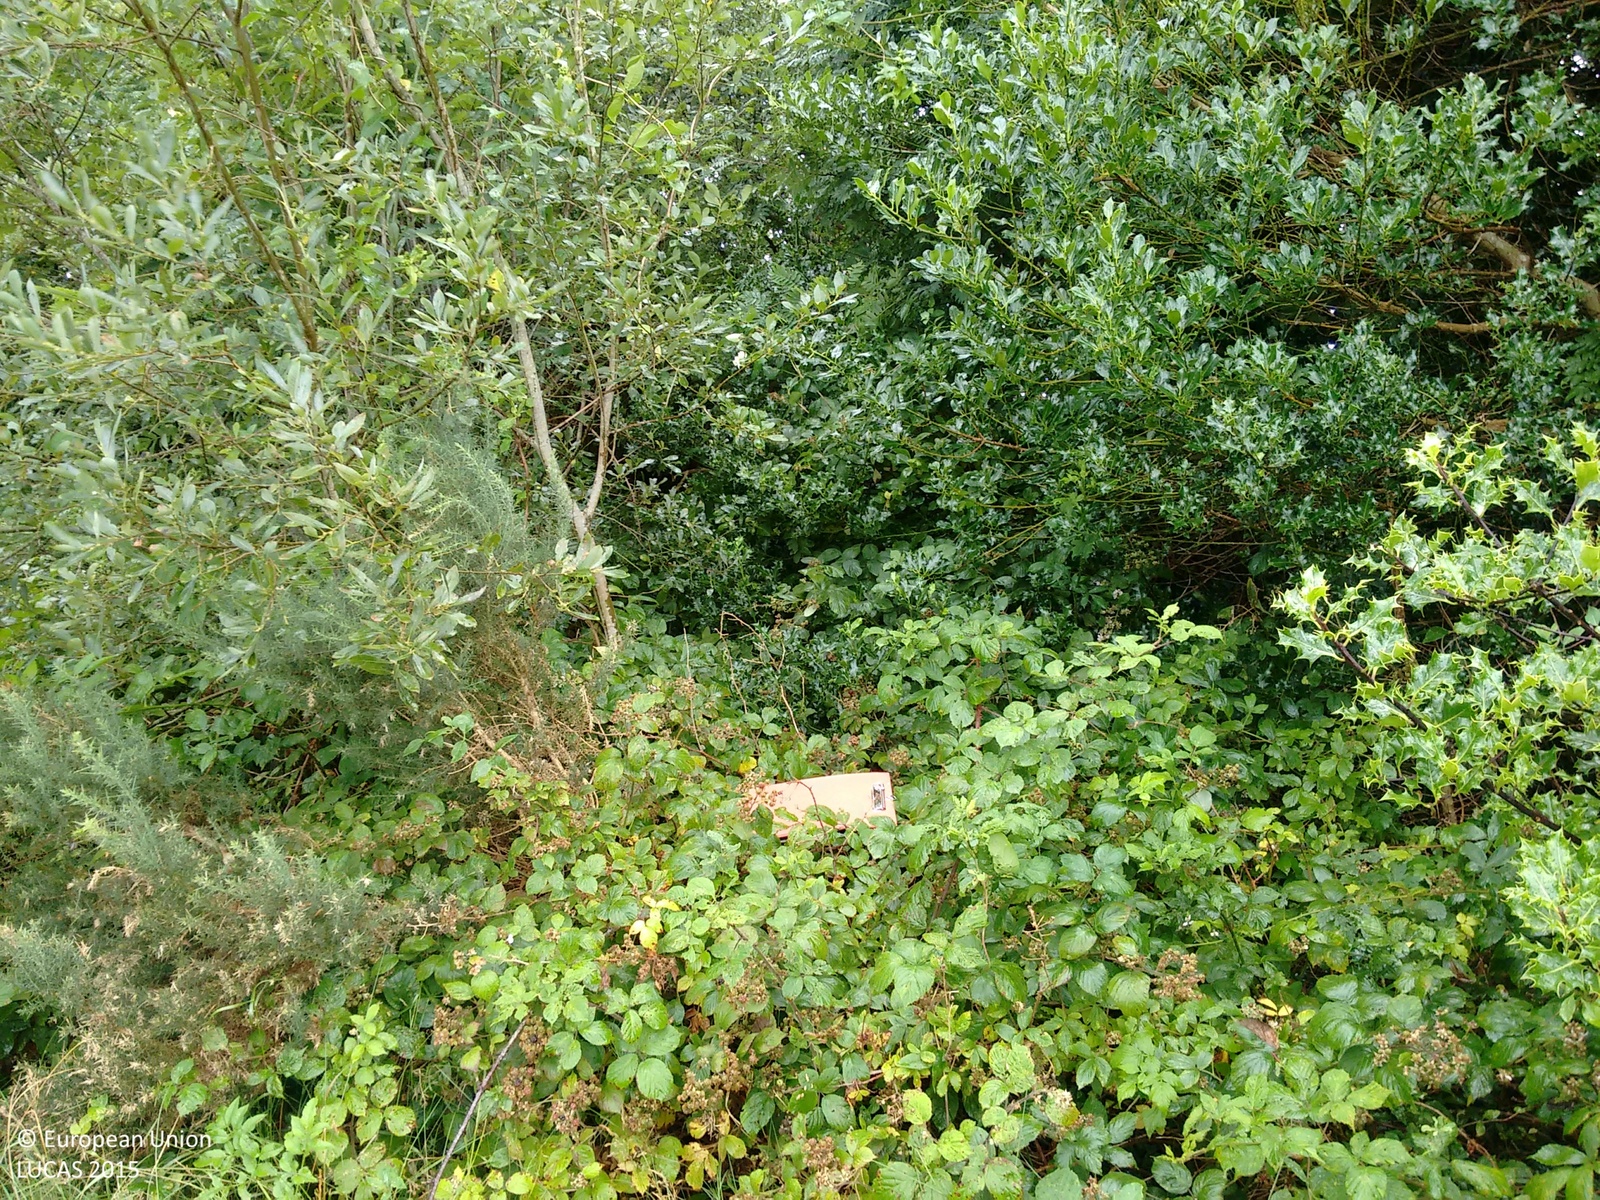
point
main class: Woodland
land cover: Broadleaved woodland
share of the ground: > 75 %
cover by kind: broadleaved forest trees 80 %, herbaceous plants 20 %
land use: Semi-natural and natural areas not in use
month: September
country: IE
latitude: 53.9939
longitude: -9.3058
